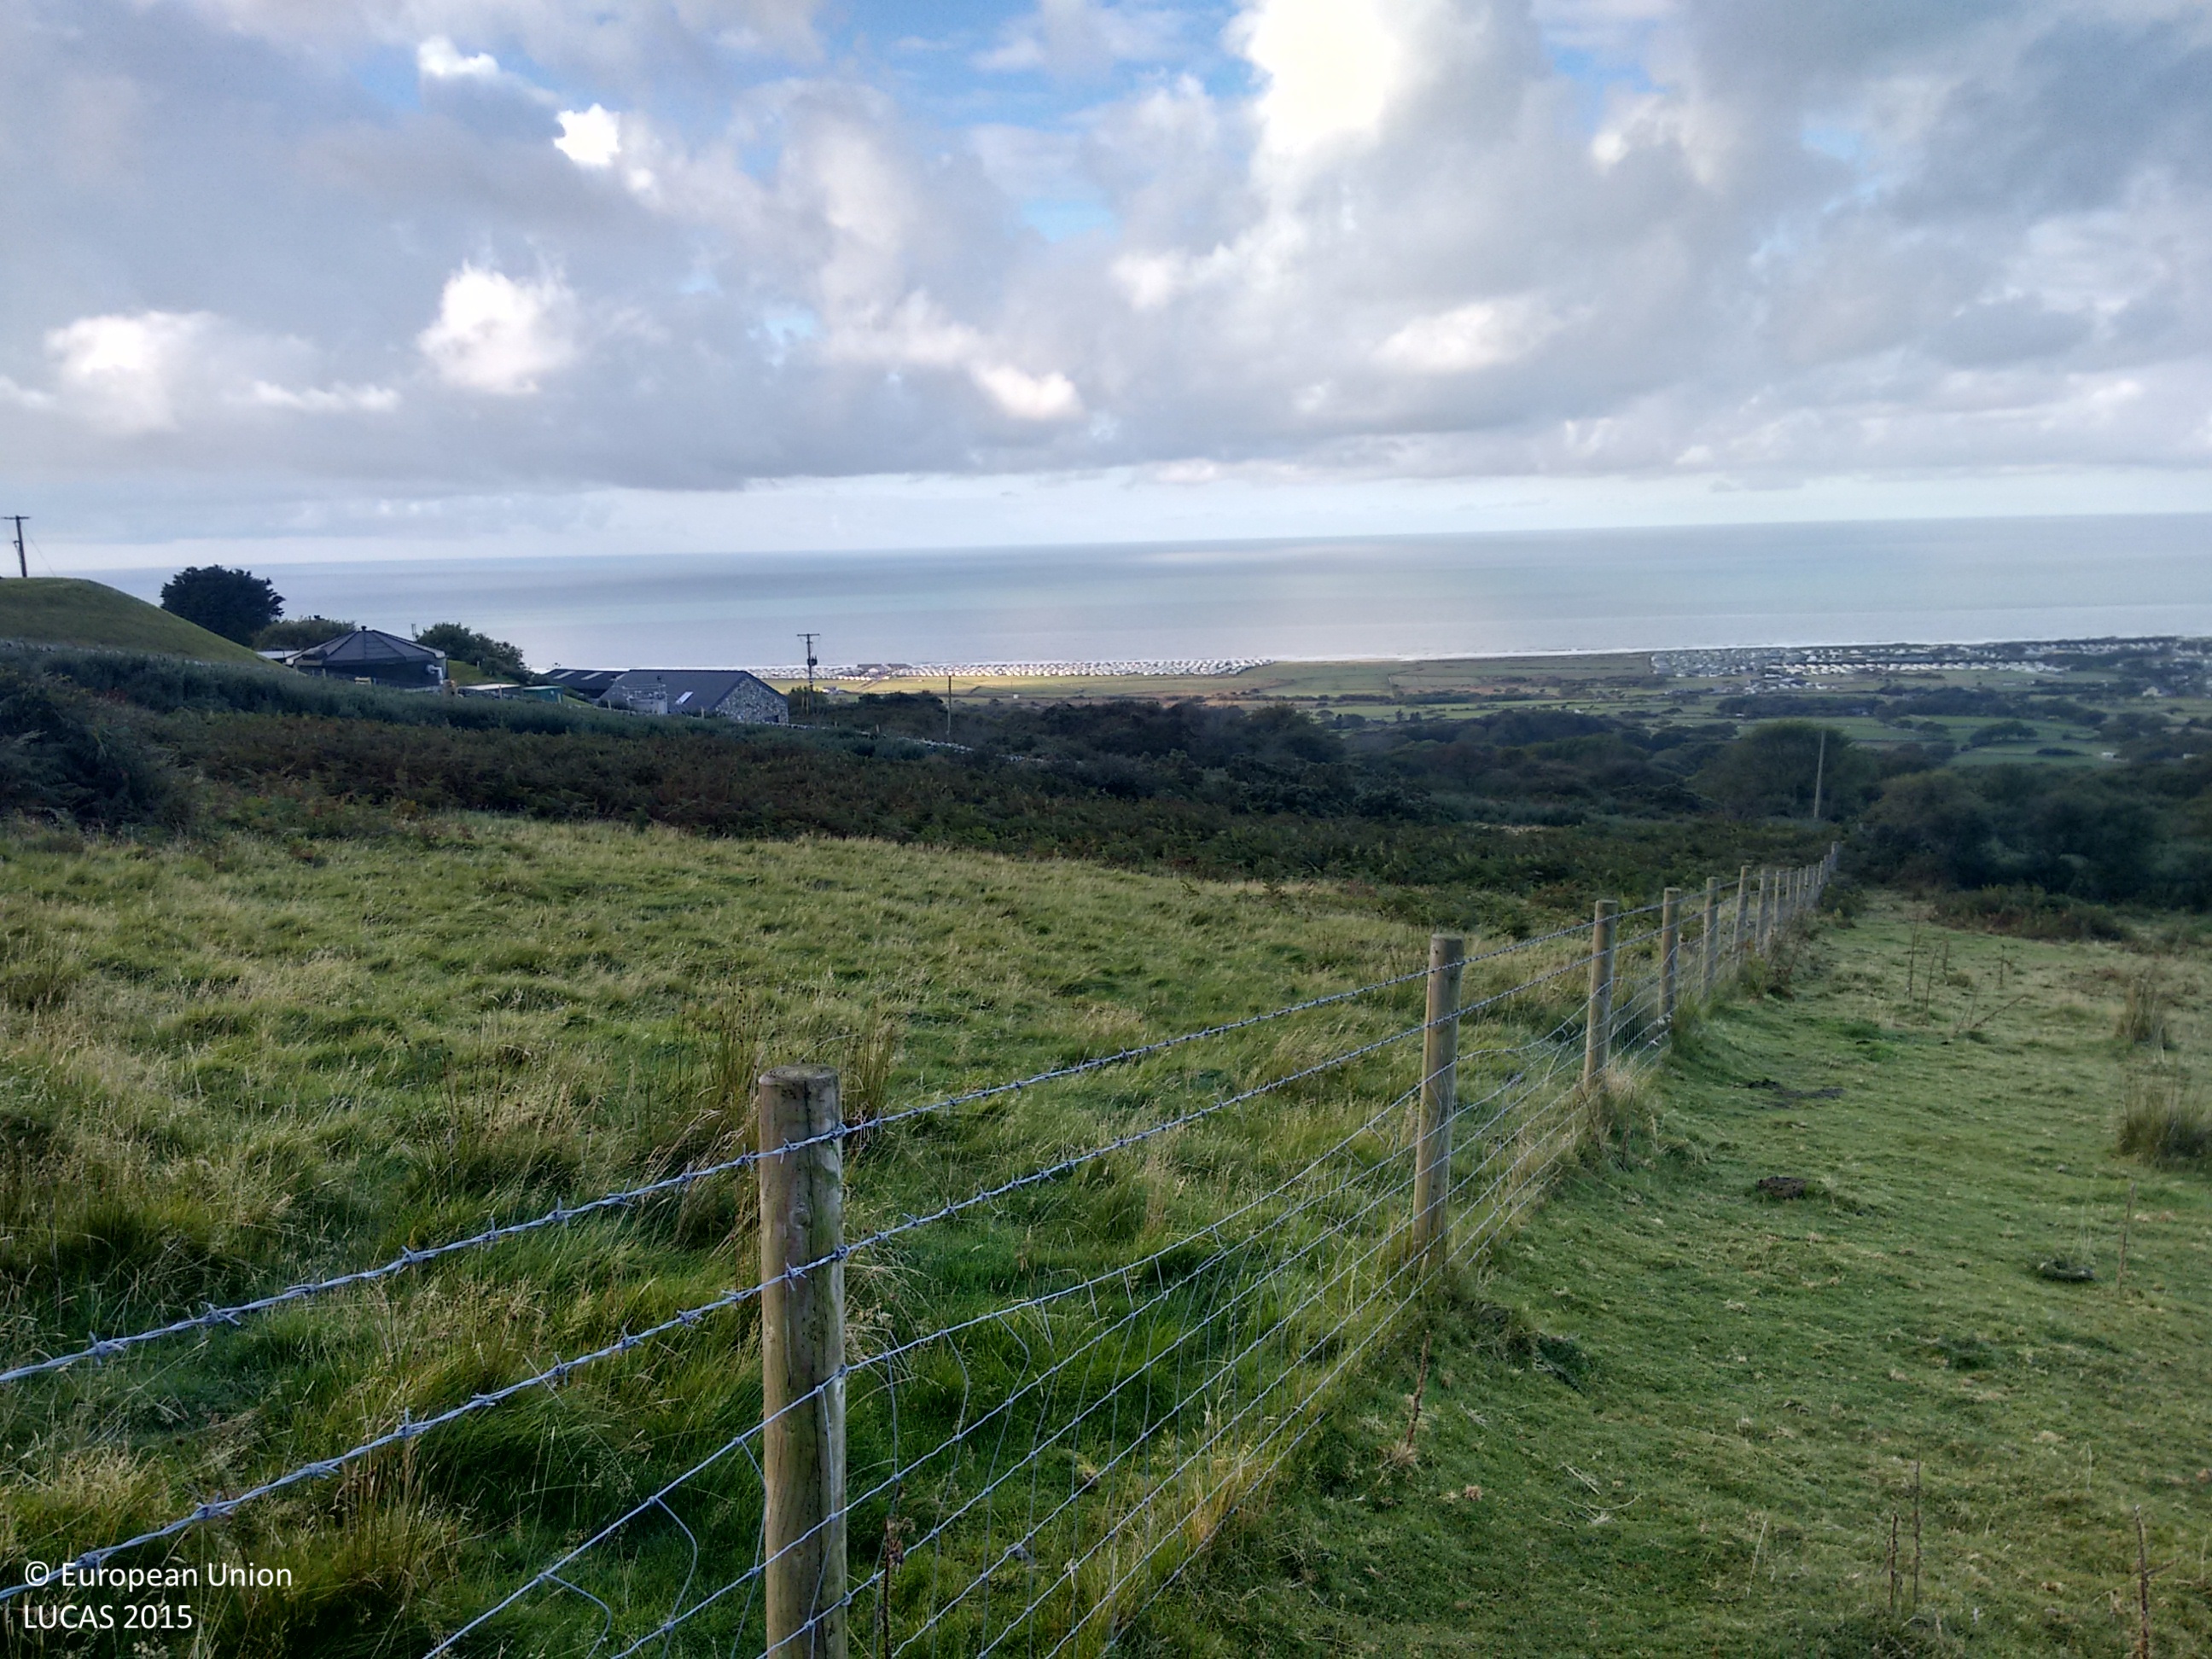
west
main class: Grassland
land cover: Grassland without tree/shrub cover
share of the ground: > 75 %
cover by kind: herbaceous plants 100 %
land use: Agriculture (excluding fallow land and kitchen gardens)
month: October
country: GB
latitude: 52.7752
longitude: -4.0747
